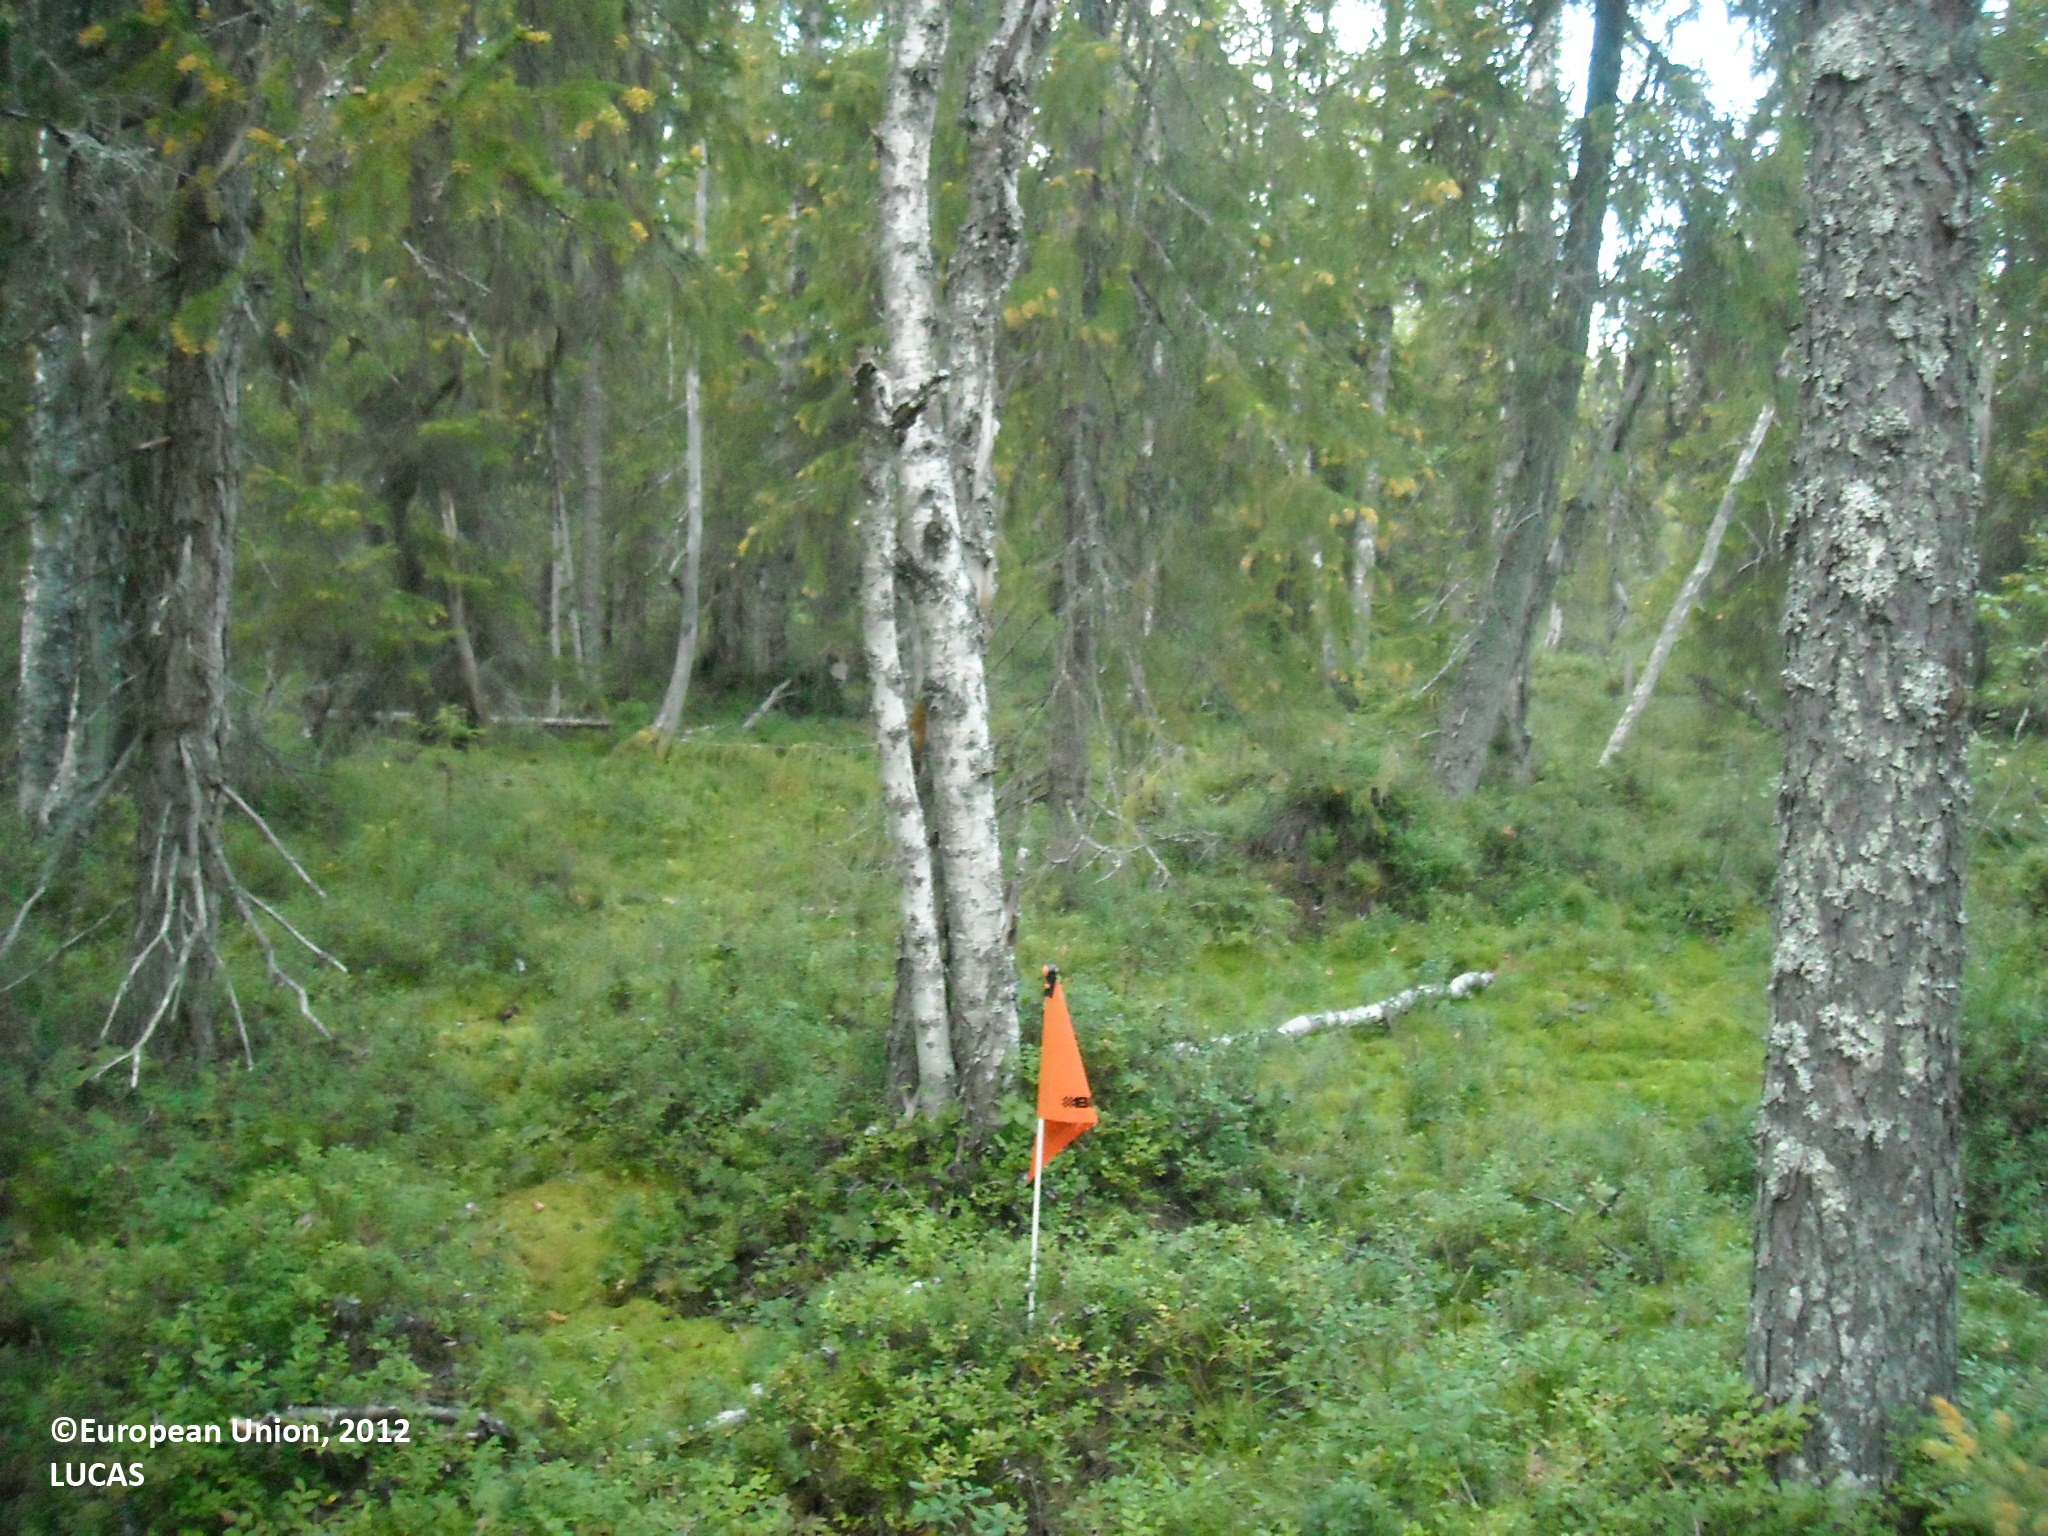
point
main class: Woodland
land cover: Spruce dominated mixed woodland
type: mire and swamp forests
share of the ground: > 75 %
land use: Forestry
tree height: > 5 m
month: August
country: FI
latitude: 65.4345
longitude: 27.7502
